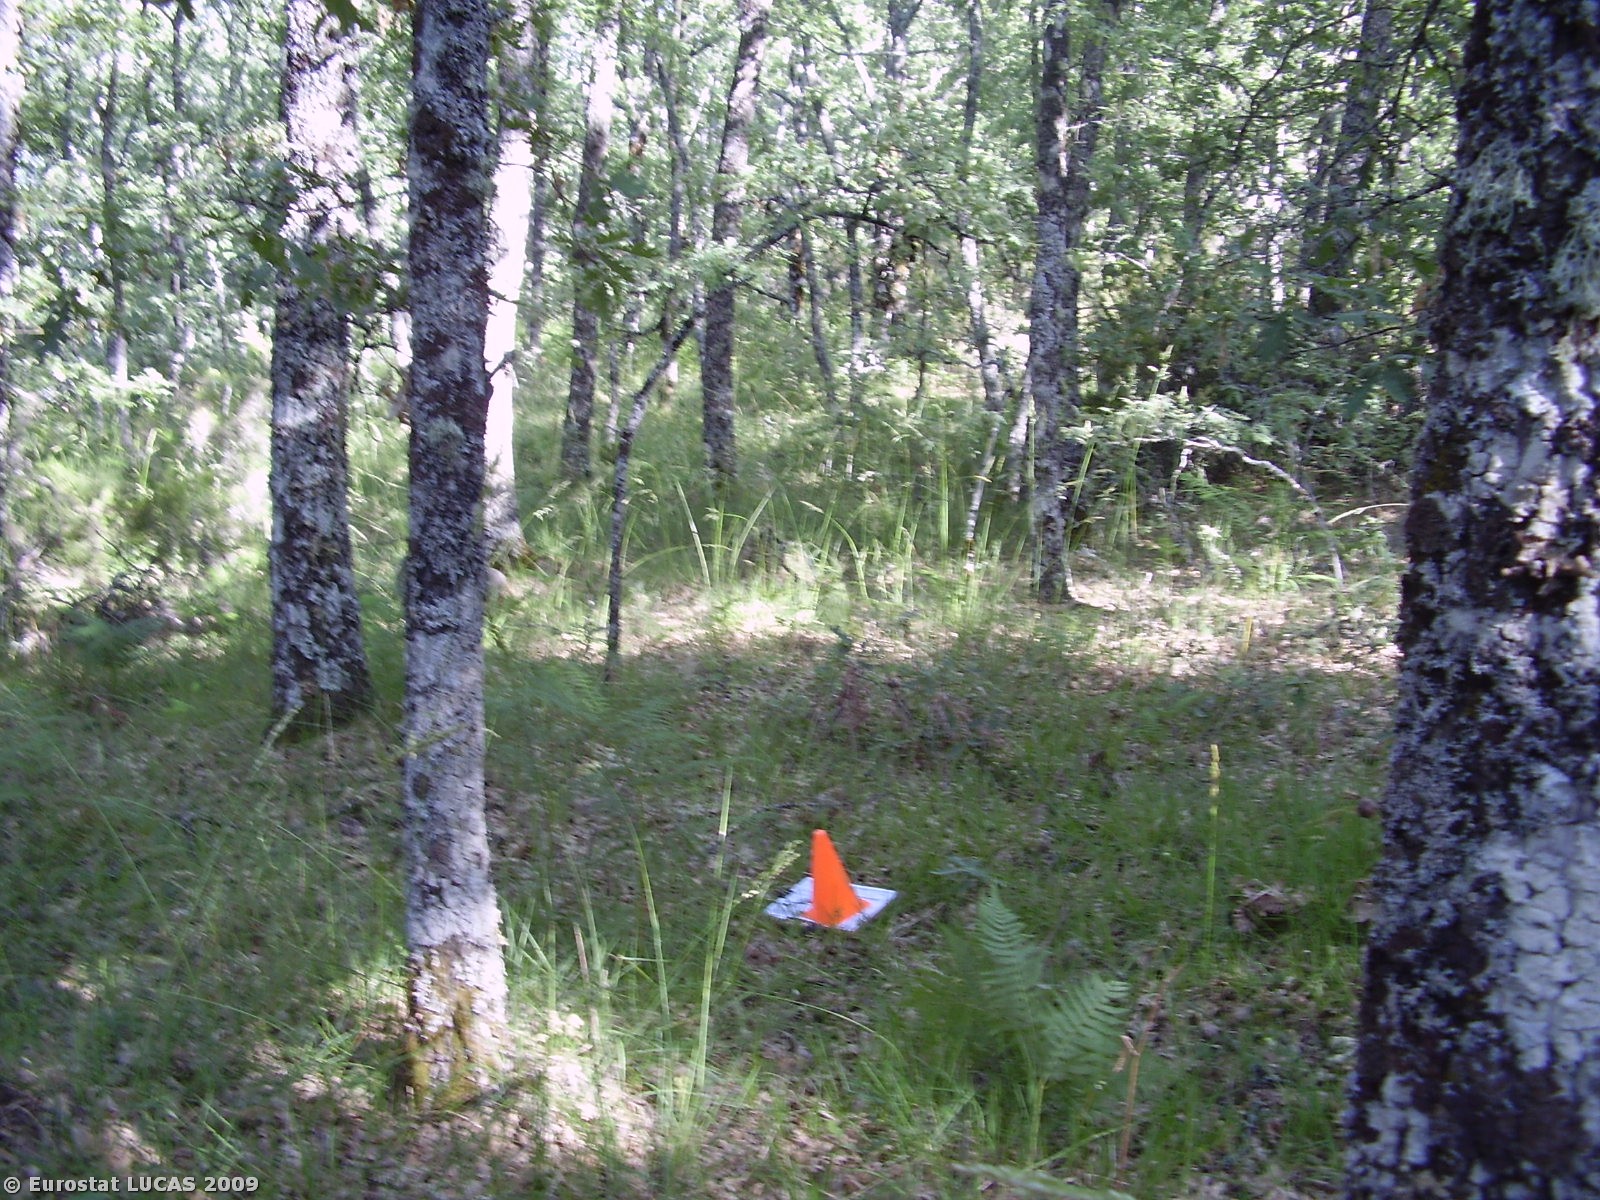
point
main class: Woodland
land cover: Broadleaved woodland
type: thermophilous deciduous forest
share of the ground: 50 - 75 %
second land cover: Spontaneously vegetated surfaces
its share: 25 - 50 %
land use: Forestry
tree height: > 5 m
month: June
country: PT
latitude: 41.8541
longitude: -6.9705
